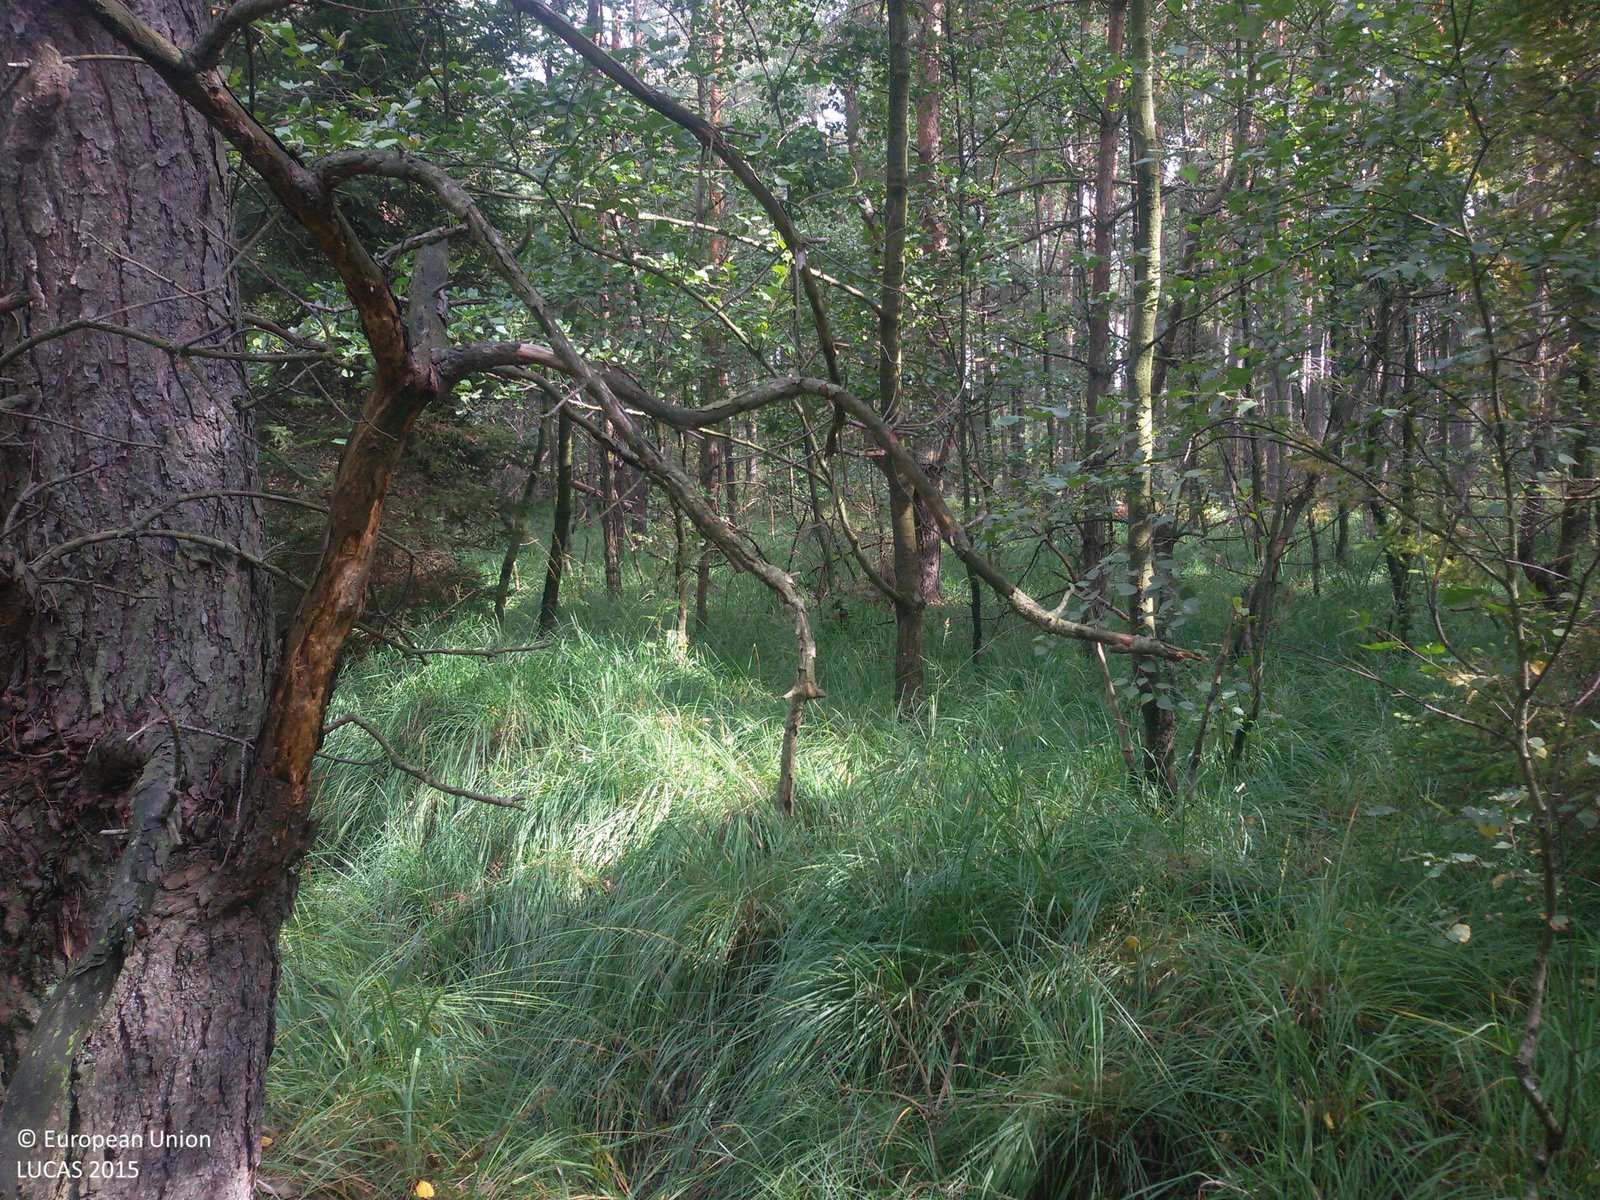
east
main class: Woodland
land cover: Pine dominated mixed woodland
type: hemiboreal forest and nemoral coniferous forest and mixed broadleaved-coniferous forest
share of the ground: > 75 %
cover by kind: coniferous forest trees 60 %, broadleaved forest trees 20 %, herbaceous plants 10 %, lichens and mosses 10 %
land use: Forestry
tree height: > 5 m
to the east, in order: Pine dominated mixed woodland; Pine dominated coniferous woodland; Other bare soil
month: September
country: PL
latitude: 50.6478
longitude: 18.6902
